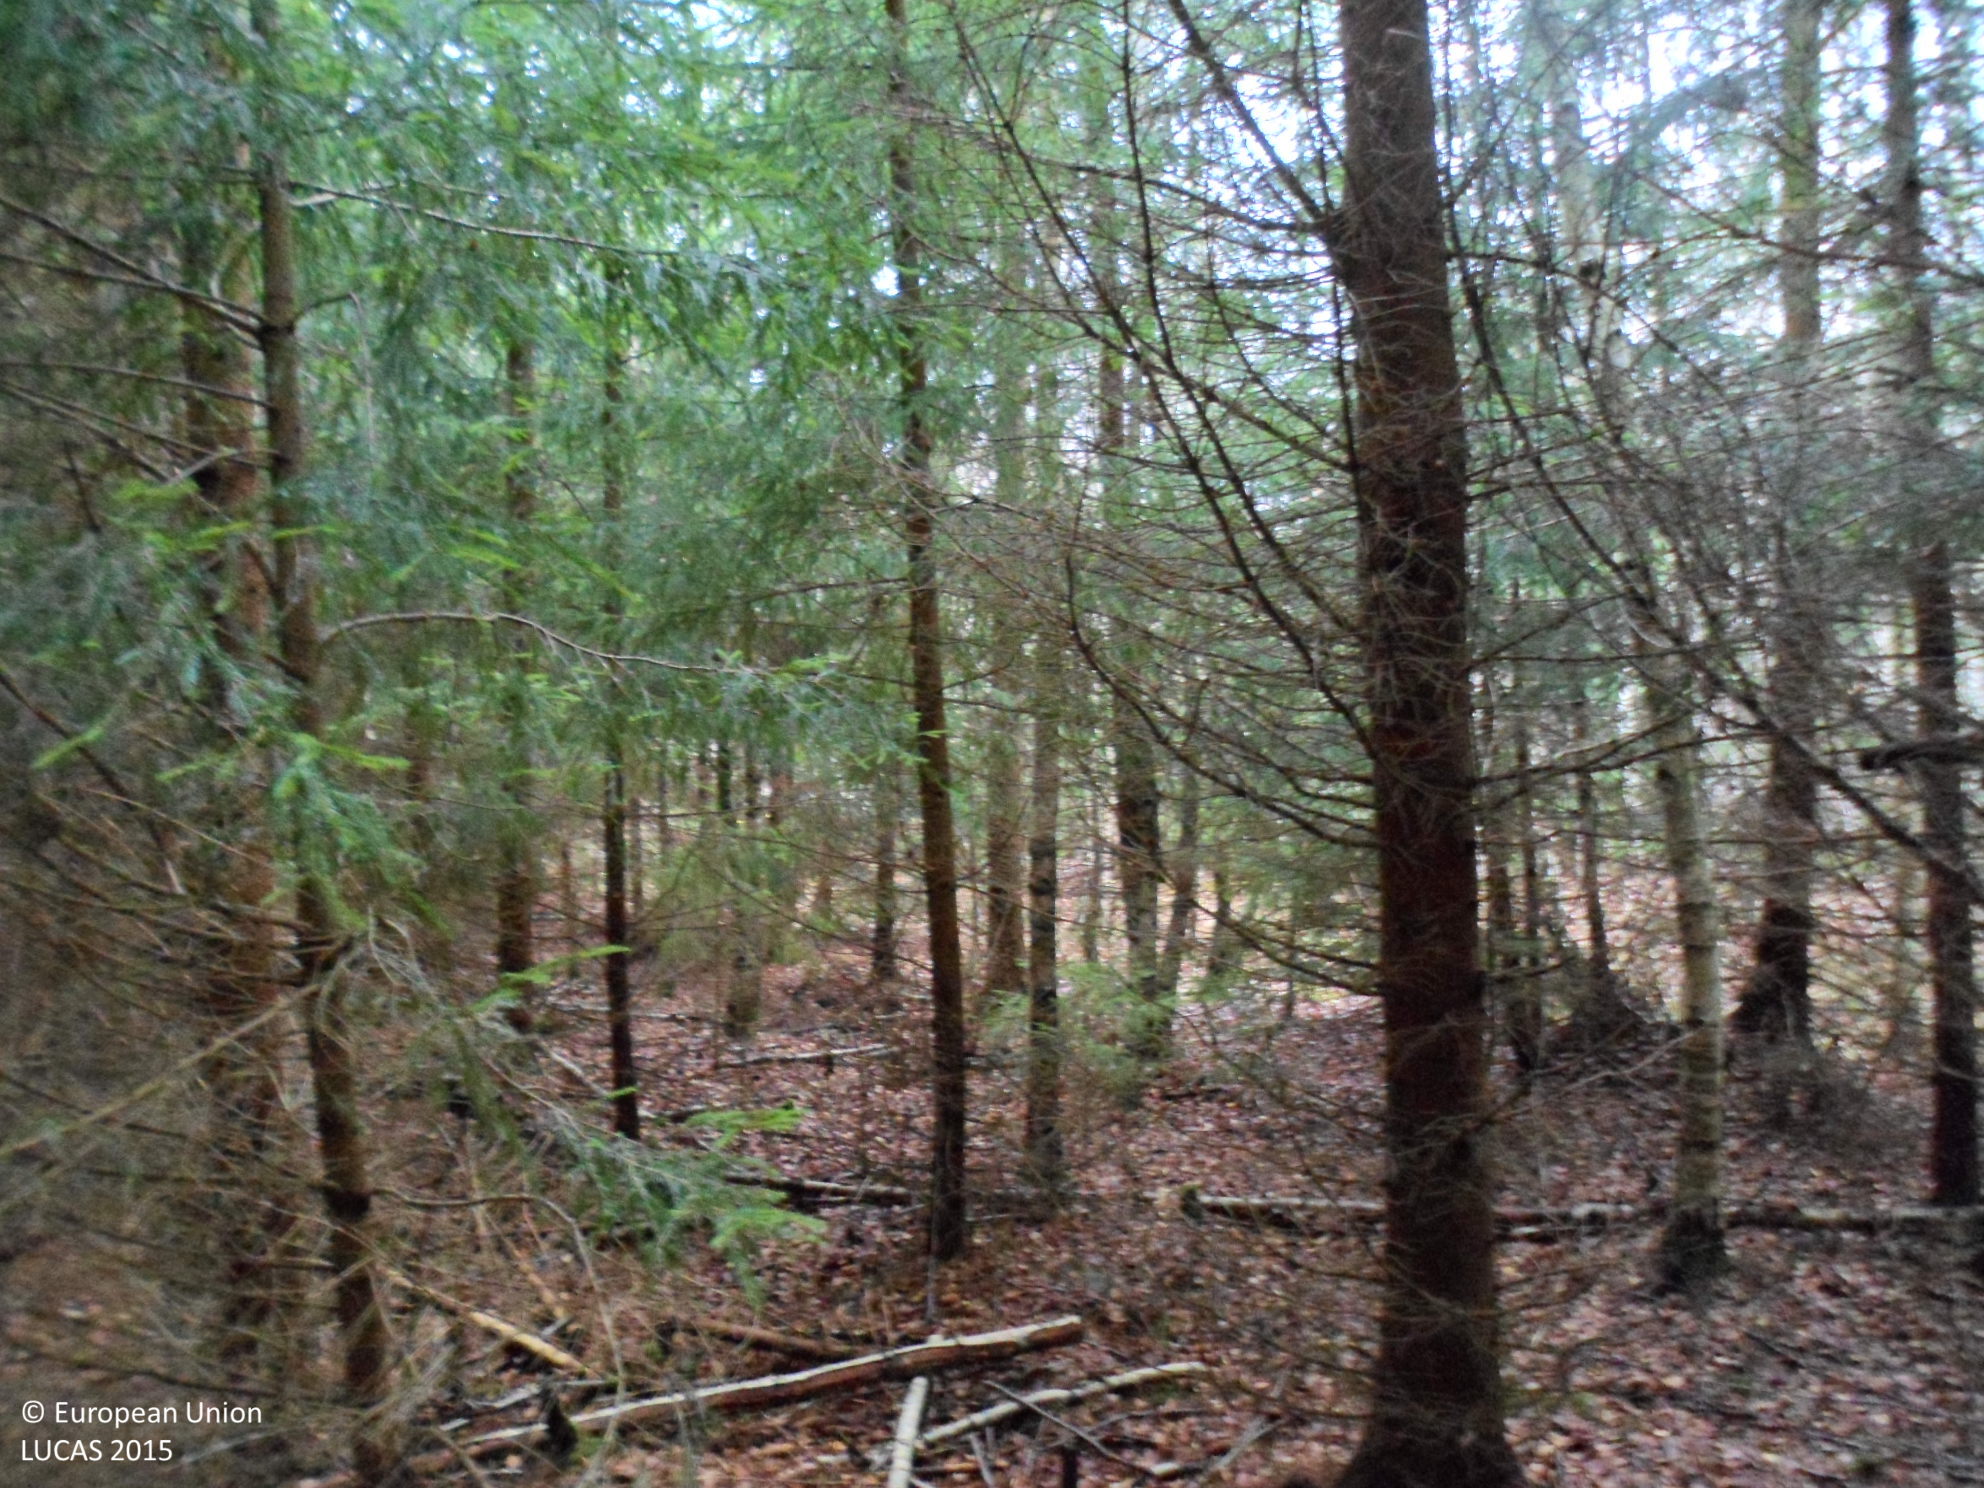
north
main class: Woodland
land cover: Spruce dominated coniferous woodland
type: boreal forest
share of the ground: > 75 %
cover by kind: coniferous forest trees 75 %, unconsolidated bare surface 15 %, broadleaved forest trees 5 %, lichens and mosses 5 %
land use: Forestry
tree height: > 5 m
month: November
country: SE
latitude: 56.7925
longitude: 15.8766
